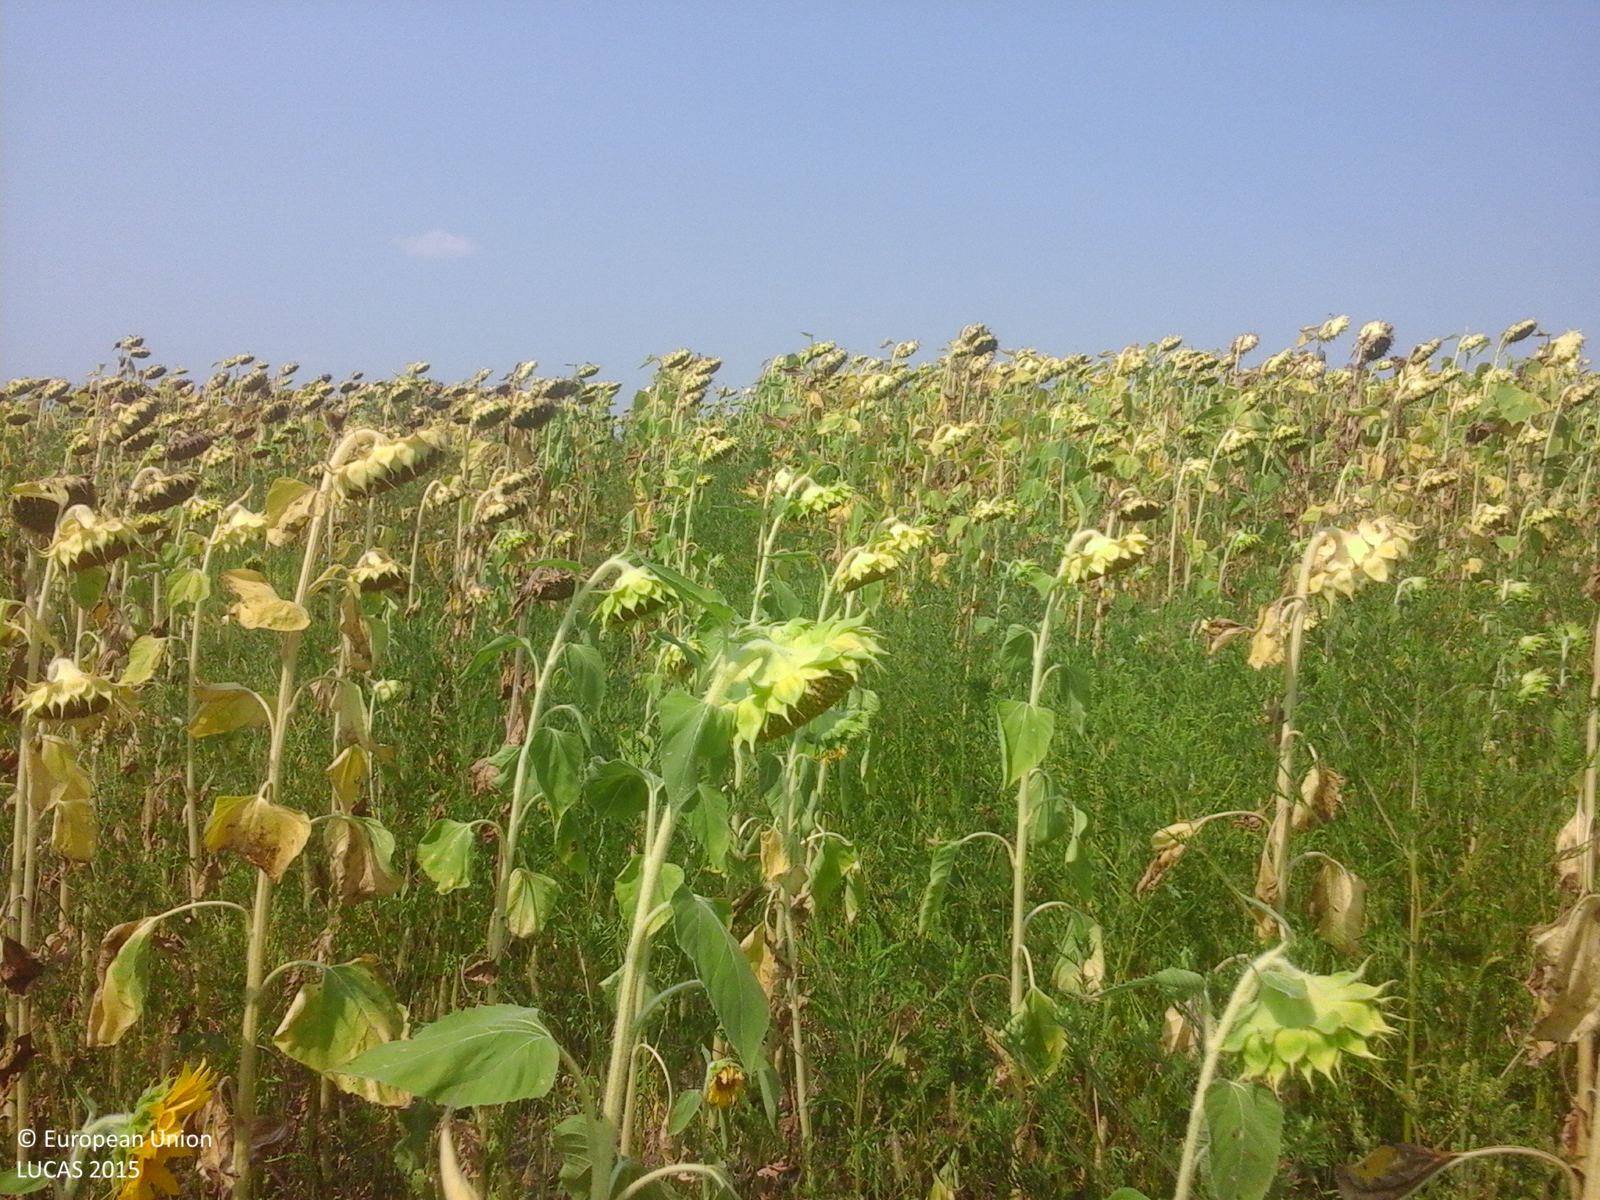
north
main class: Cropland
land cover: Sunflower
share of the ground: > 75 %
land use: Agriculture (excluding fallow land and kitchen gardens)
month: August
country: RO
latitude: 44.2179
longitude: 23.7357
